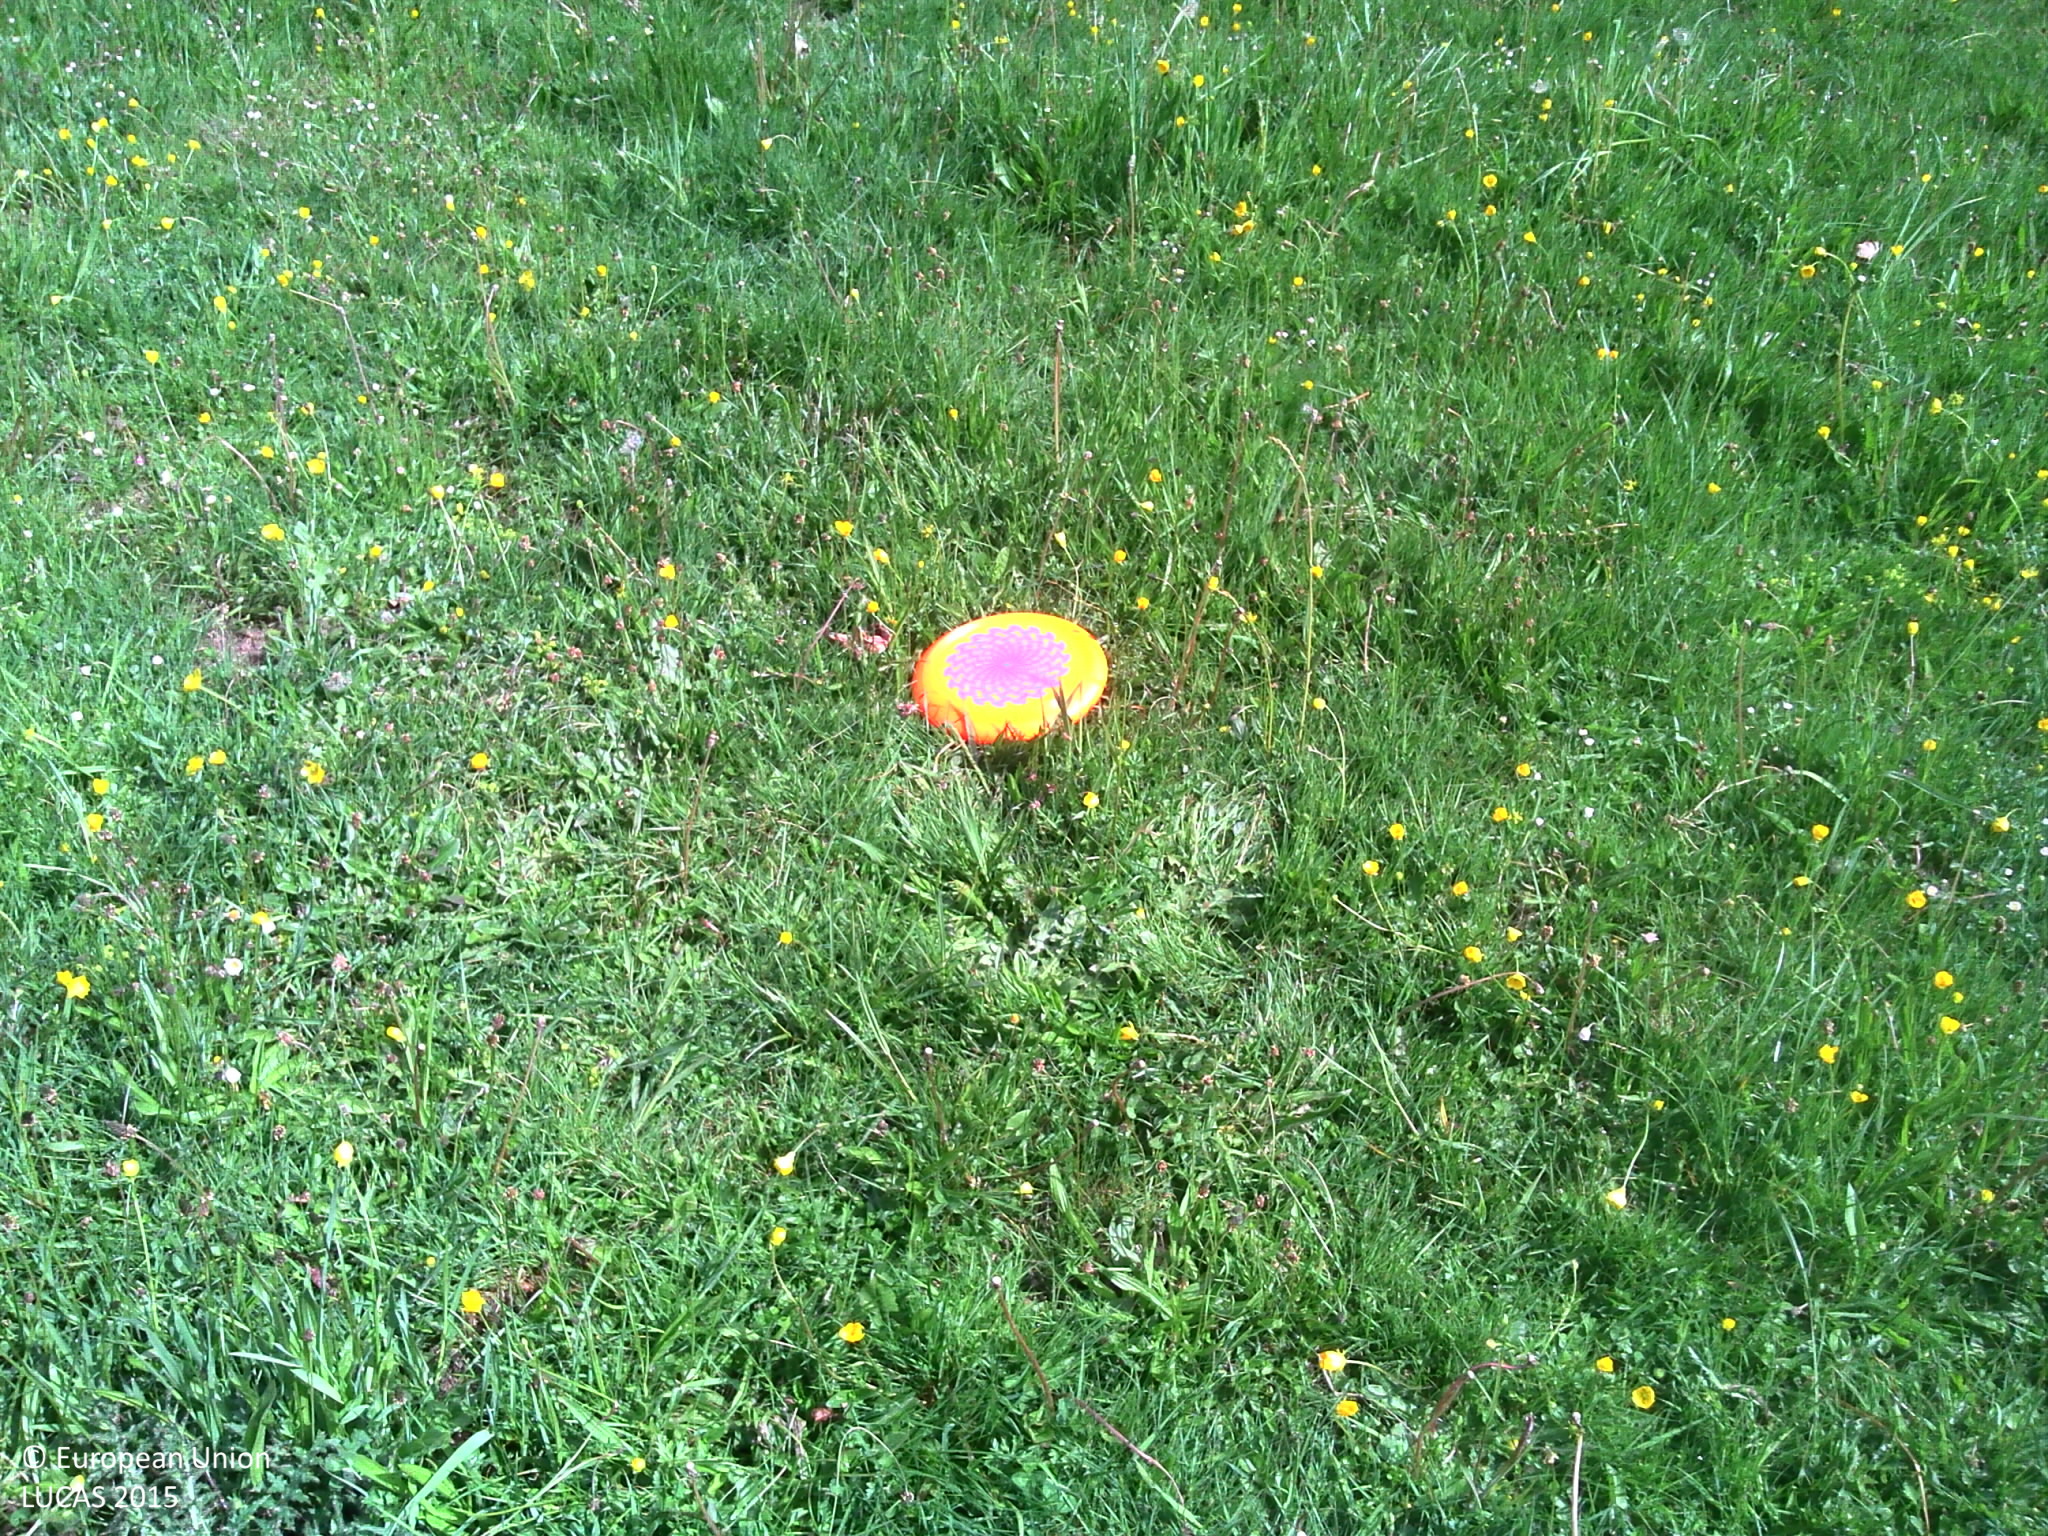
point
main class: Grassland
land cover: Grassland without tree/shrub cover
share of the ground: > 75 %
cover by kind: herbaceous plants 100 %
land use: Agriculture (excluding fallow land and kitchen gardens)
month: May
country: LU
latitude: 50.0398
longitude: 5.9359
